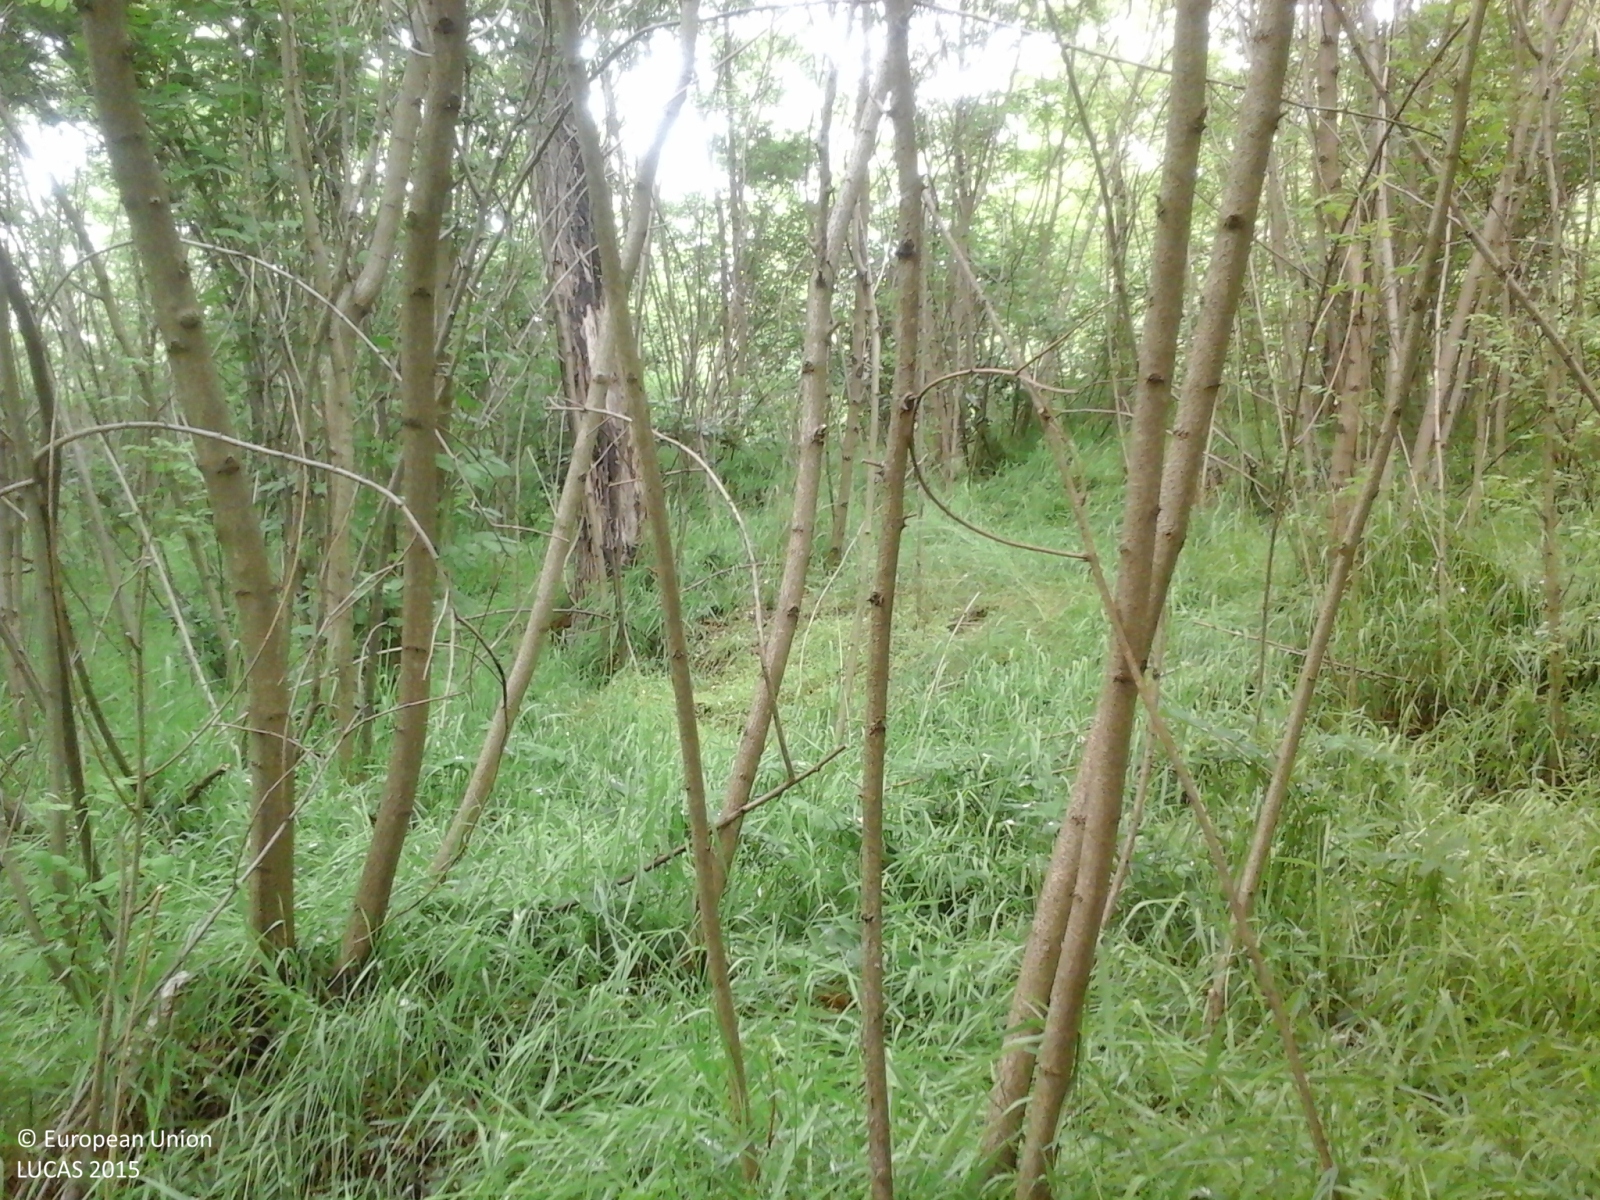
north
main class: Woodland
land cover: Broadleaved woodland
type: thermophilous deciduous forest
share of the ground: > 75 %
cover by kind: broadleaved forest trees 100 %
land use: Forestry
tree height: > 5 m
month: May
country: IT
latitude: 45.7475
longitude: 8.6011
